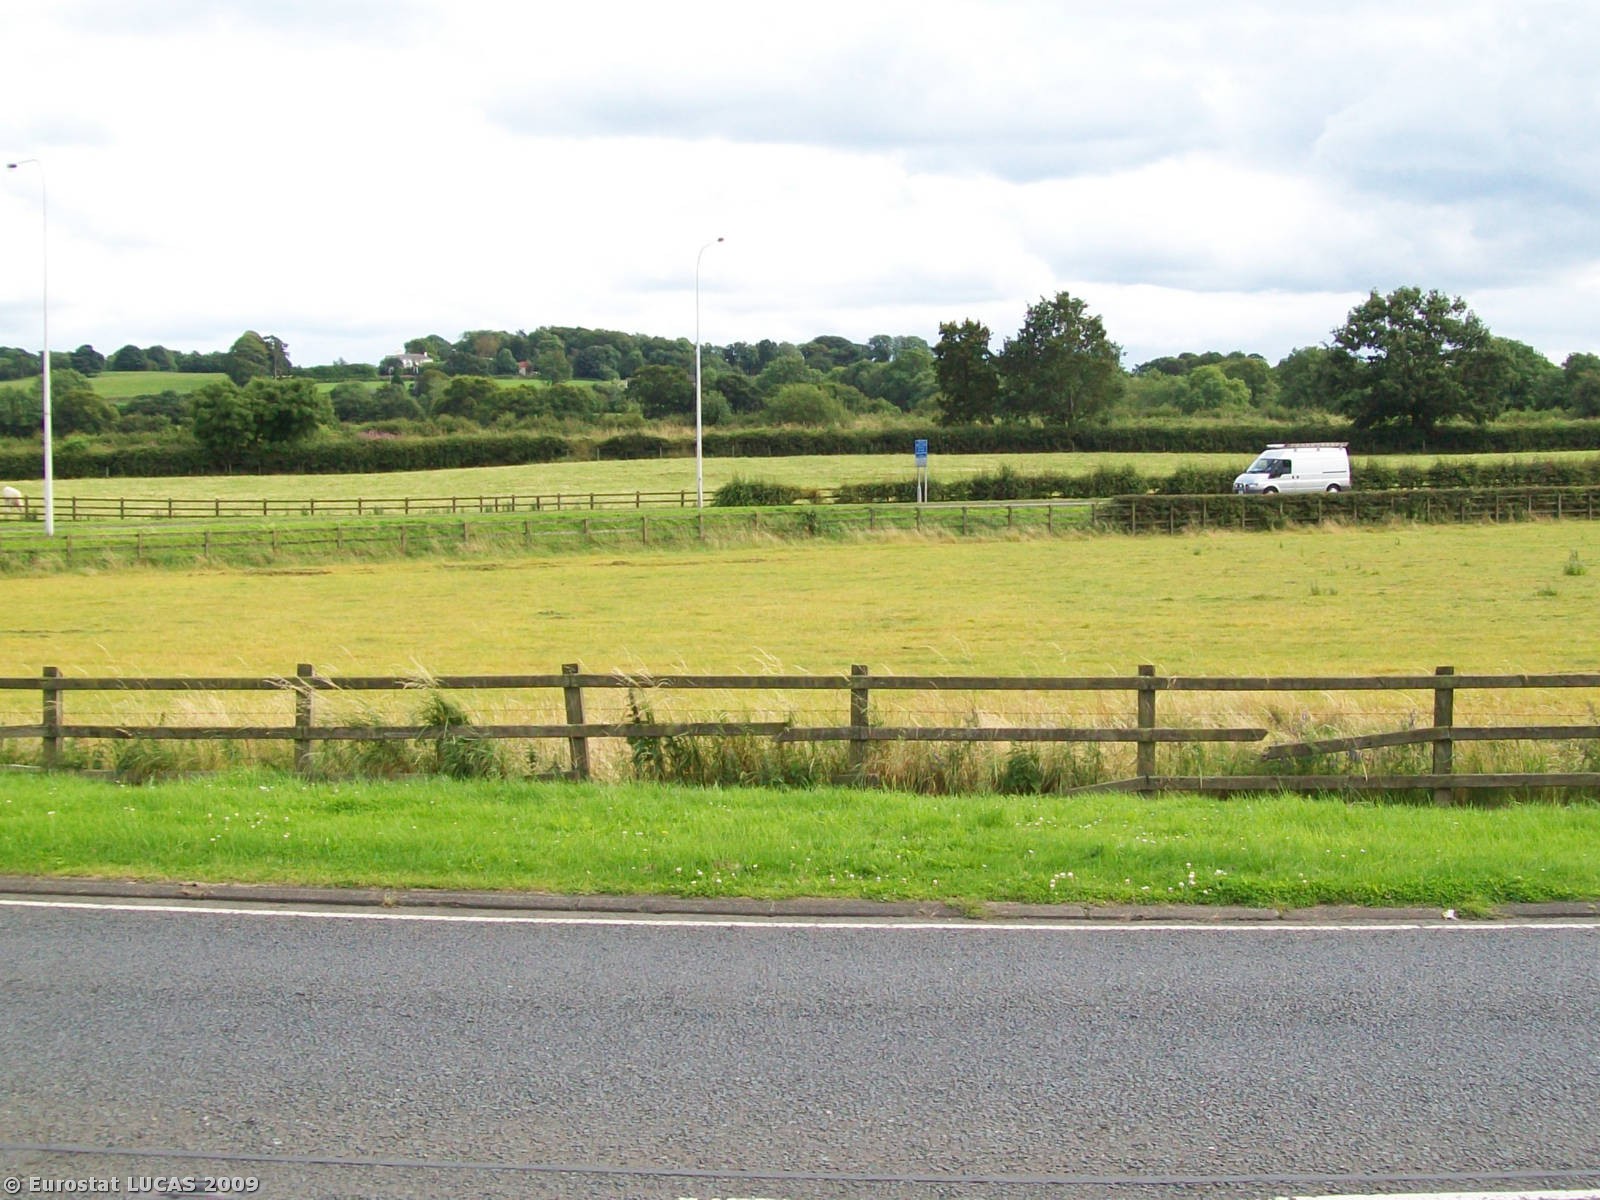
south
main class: Grassland
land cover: Grassland without tree/shrub cover
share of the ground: > 75 %
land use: Agriculture (excluding fallow land and kitchen gardens)
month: July
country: GB
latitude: 54.7002
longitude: -6.1108
